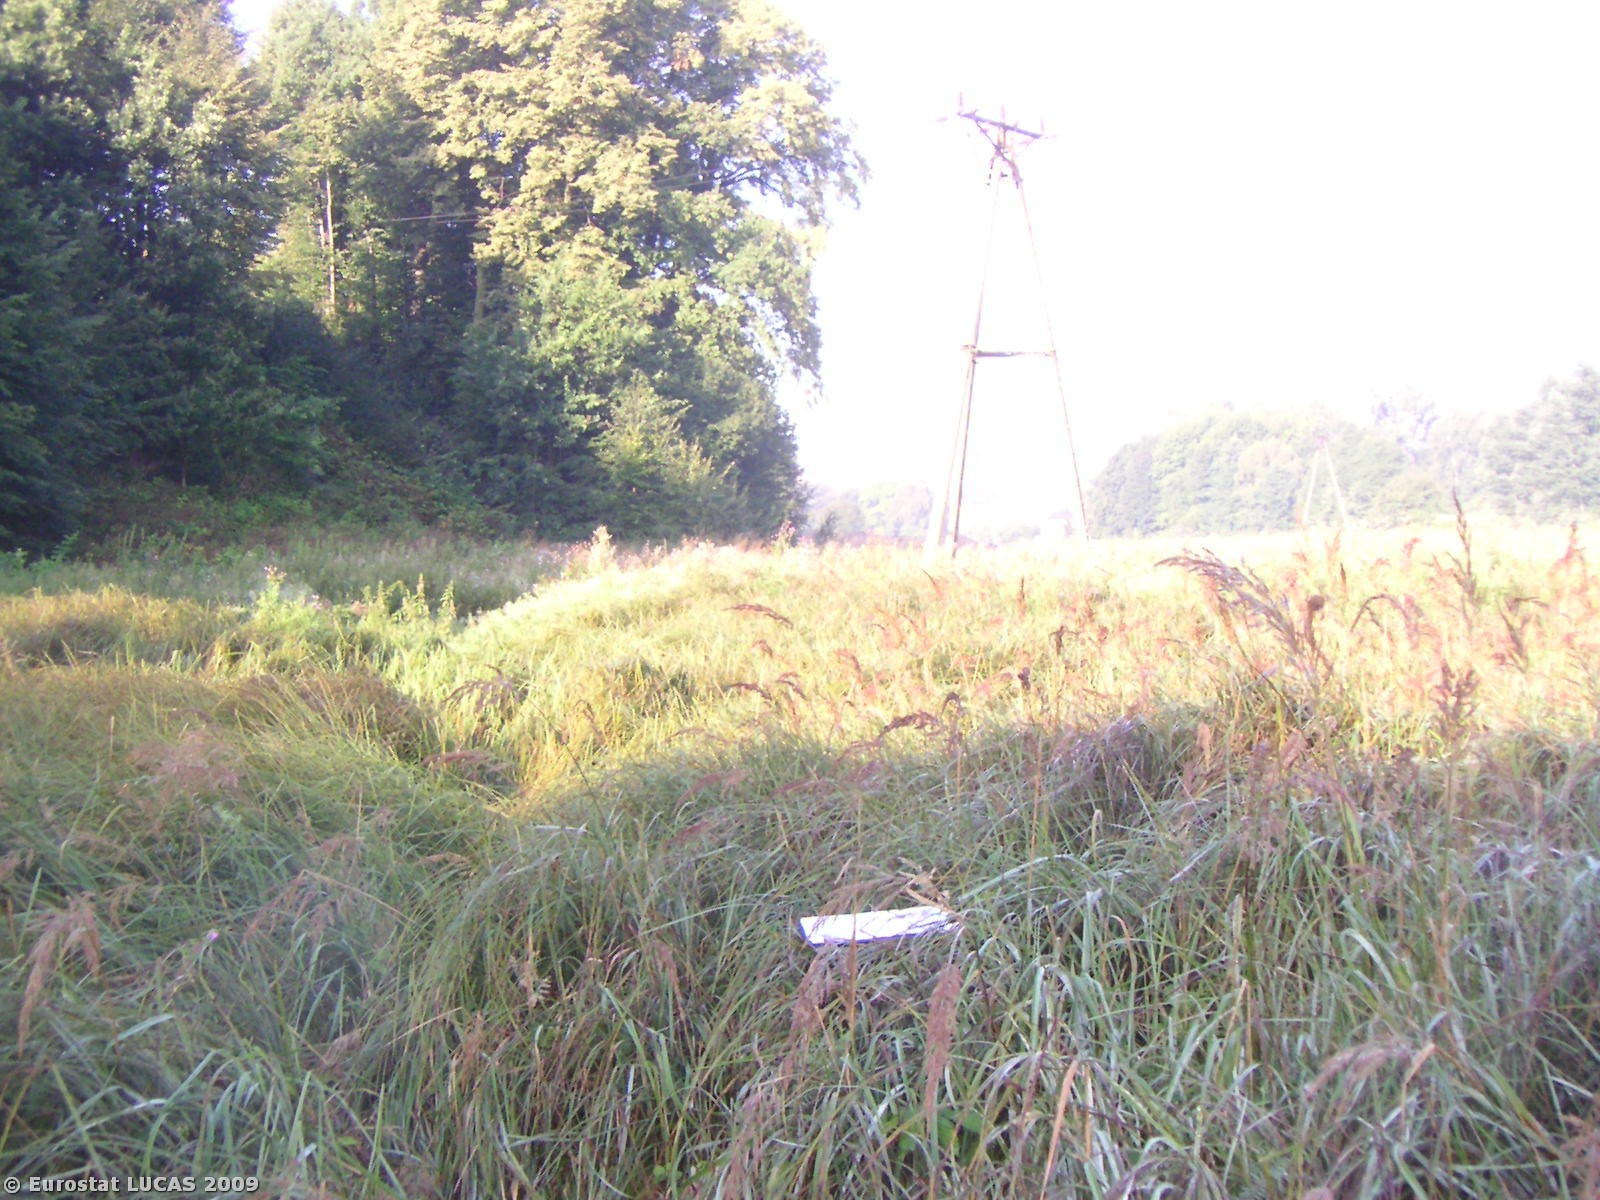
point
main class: Grassland
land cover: Spontaneously vegetated surfaces
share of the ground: > 75 %
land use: Fallow land
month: August
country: PL
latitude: 50.3674
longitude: 18.8083
